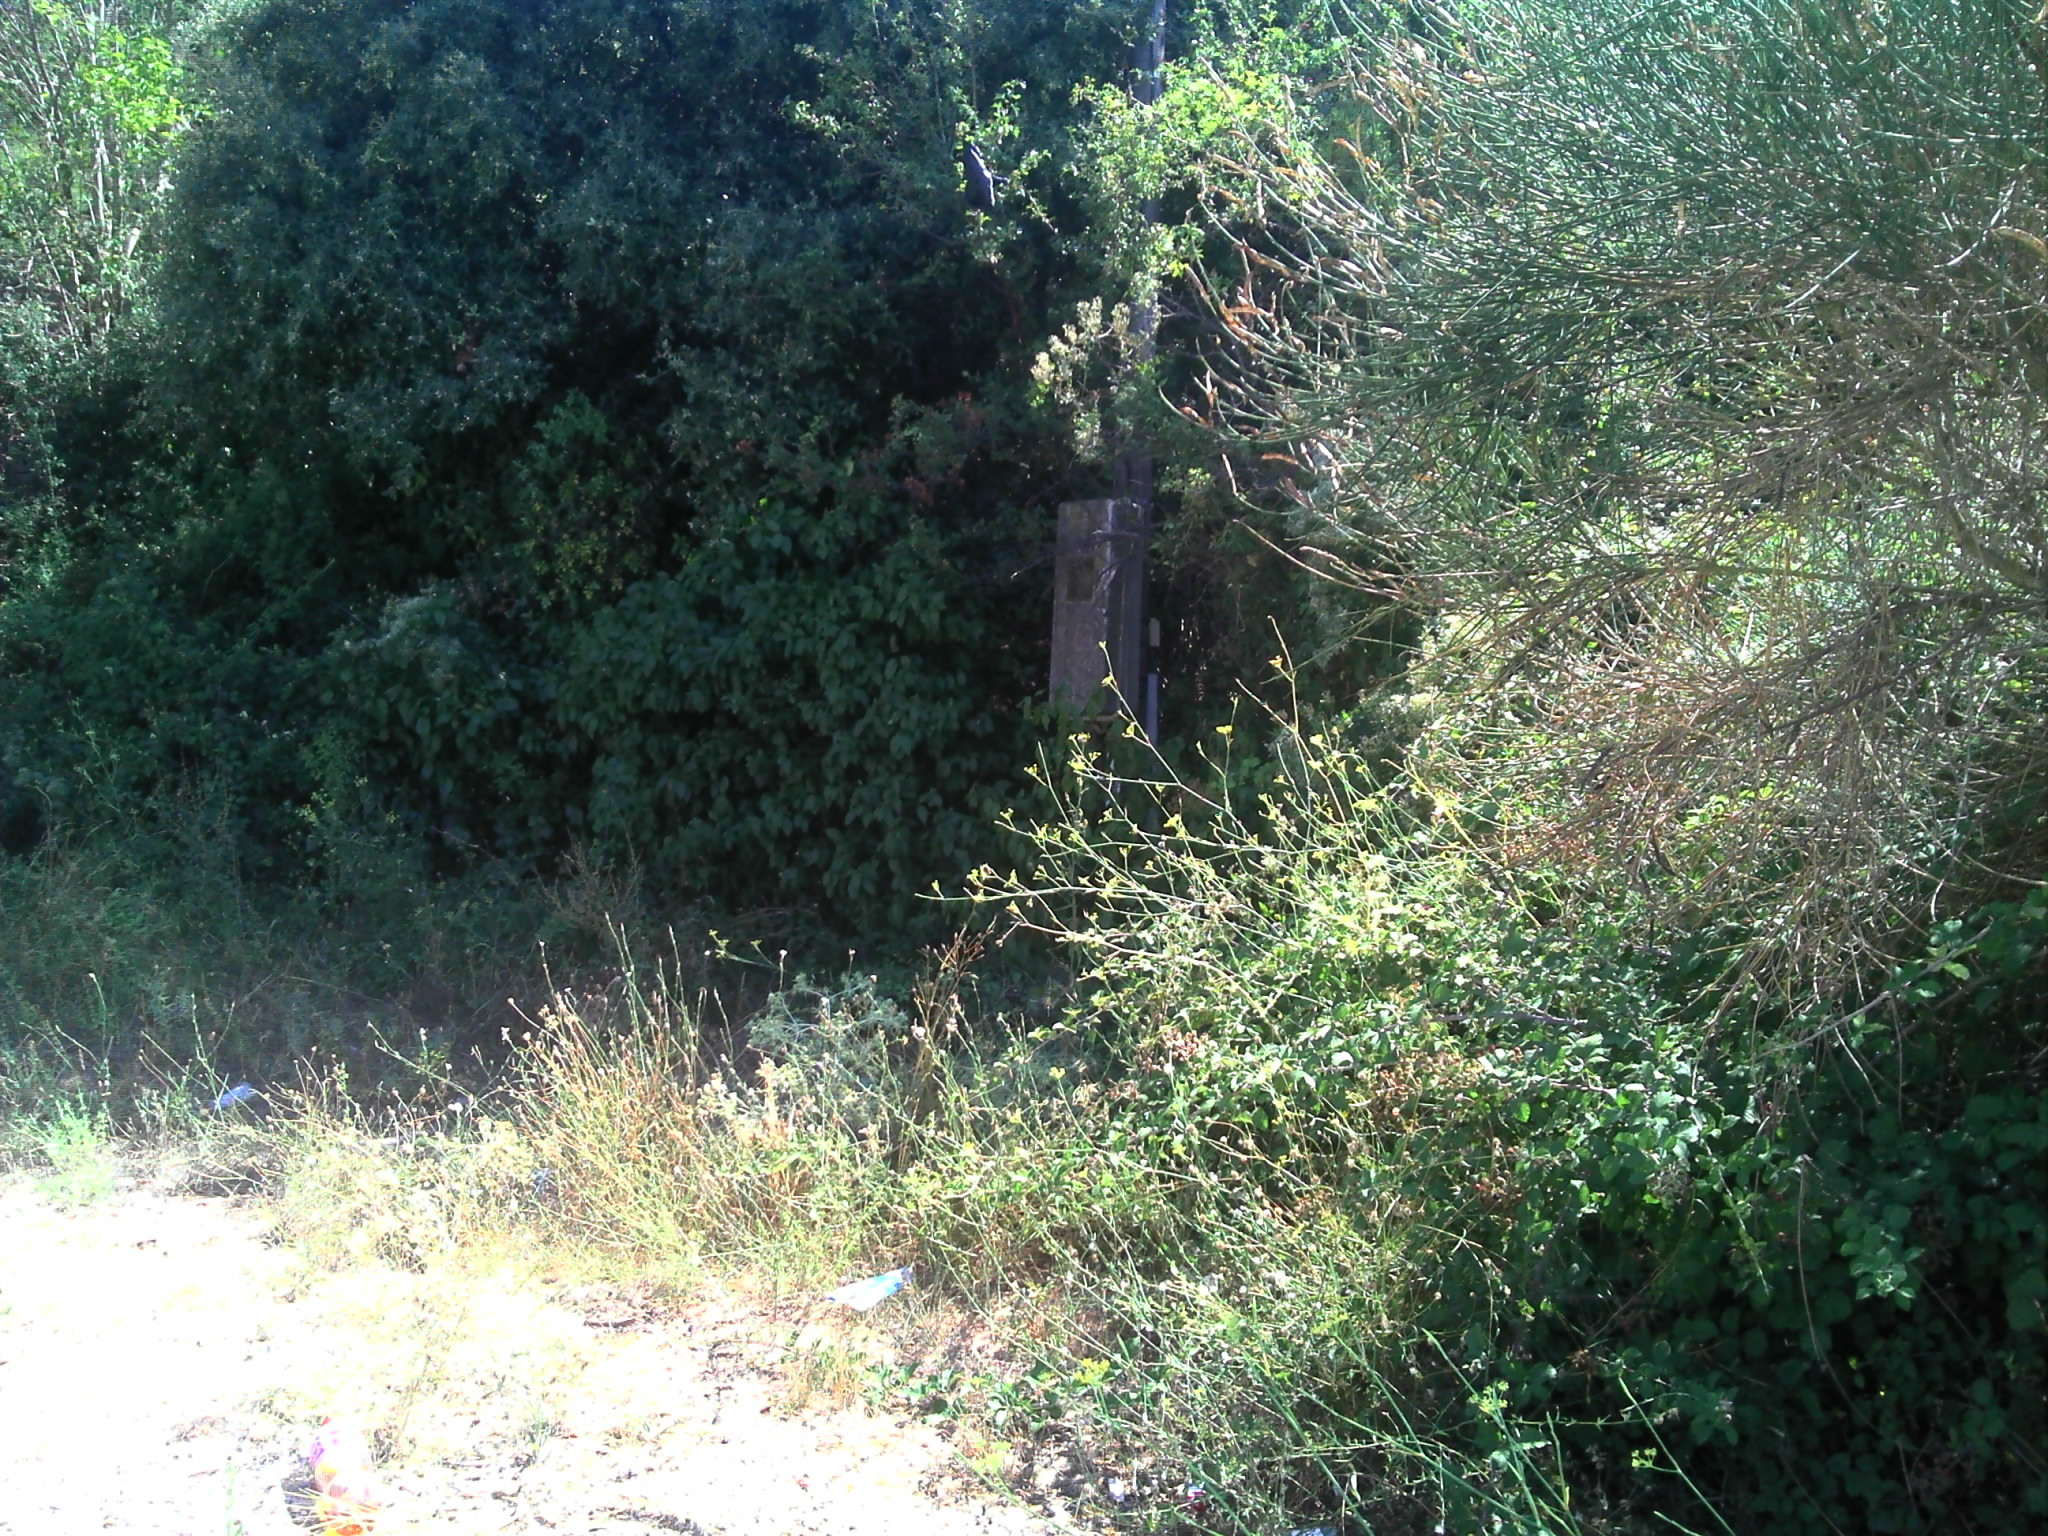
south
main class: Grassland
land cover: Grassland with sparse tree/shrub cover
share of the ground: > 75 %
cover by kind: herbaceous plants 85 %, coniferous forest trees 5 %, consolidated bare surface 5 %
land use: Residential
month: August
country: FR
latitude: 43.3940
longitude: 5.2817
